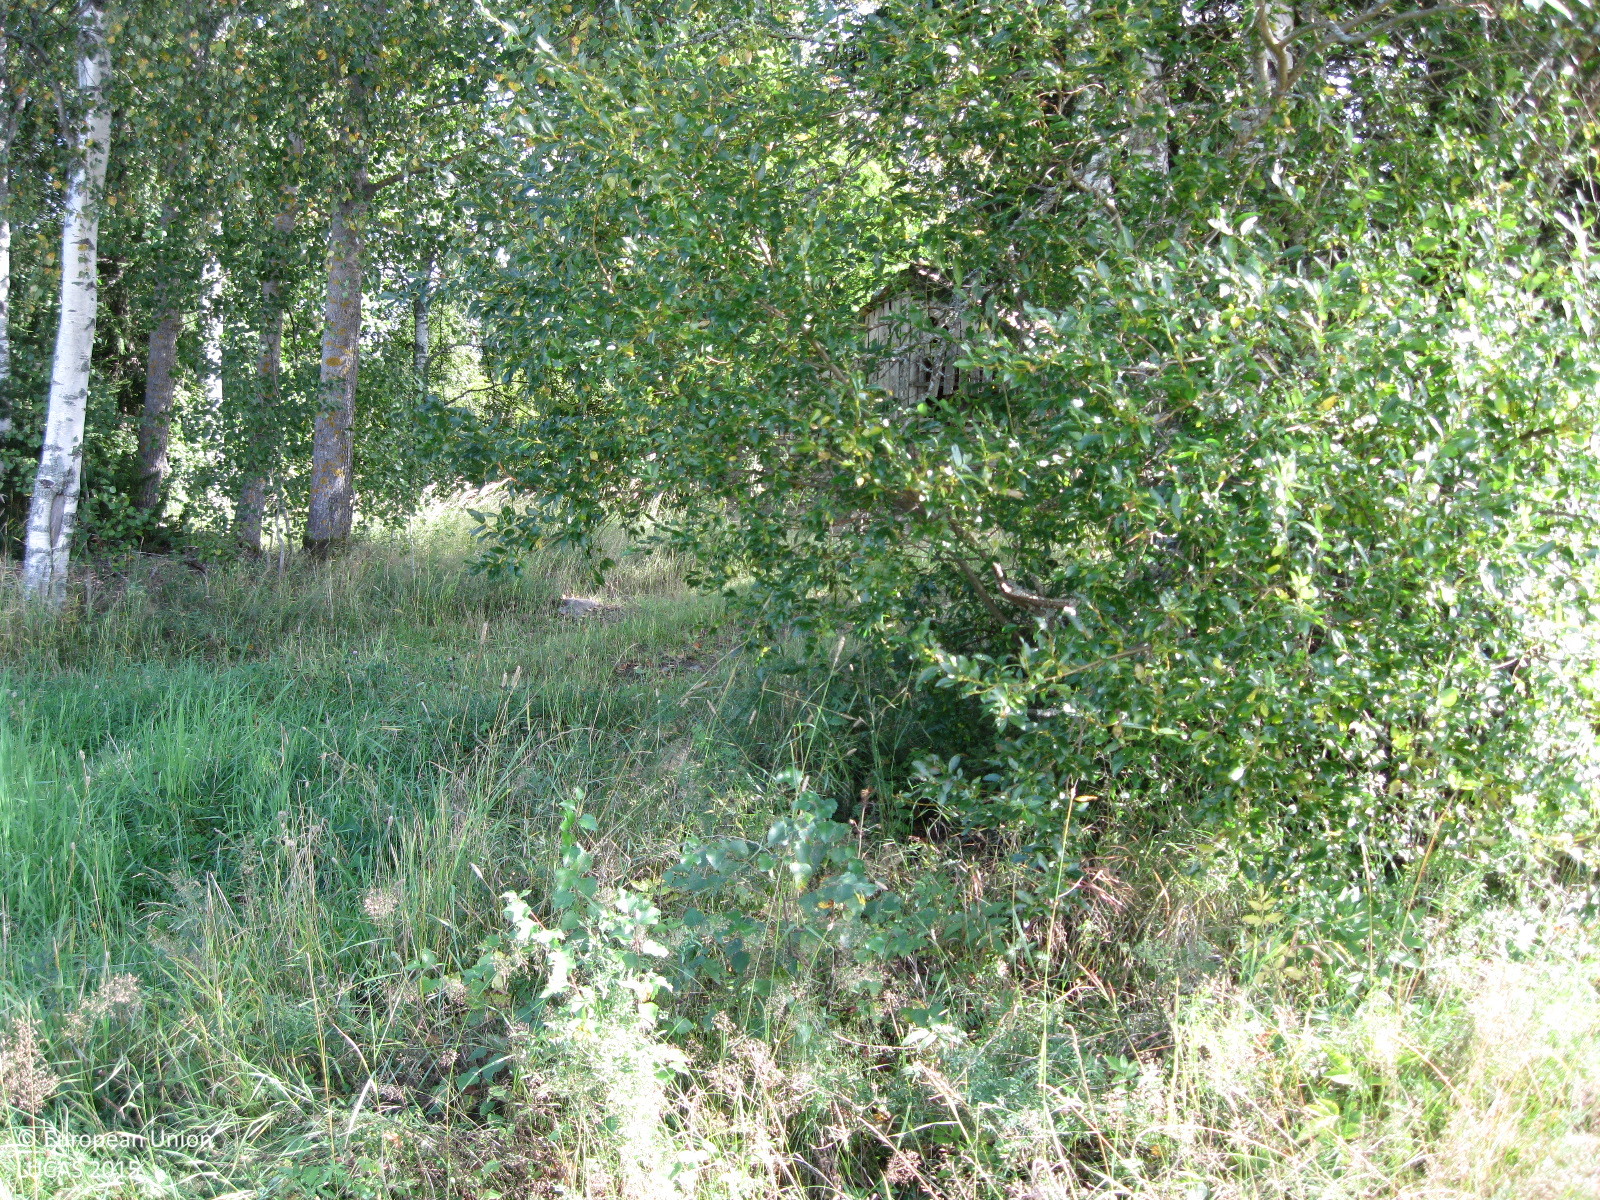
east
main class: Cropland
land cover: Oats
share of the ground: > 75 %
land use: Agriculture (excluding fallow land and kitchen gardens)
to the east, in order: Oats; Grass margins; Broadleaved woodland; Tracks; Shruby margins; Ditches and canals; Grassland without tree/shrub cover; Groves; Ditches and canals; Shrubland with sparse tree cover; Spruce dominated mixed woodland
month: September
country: FI
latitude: 60.5499
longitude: 24.4548
